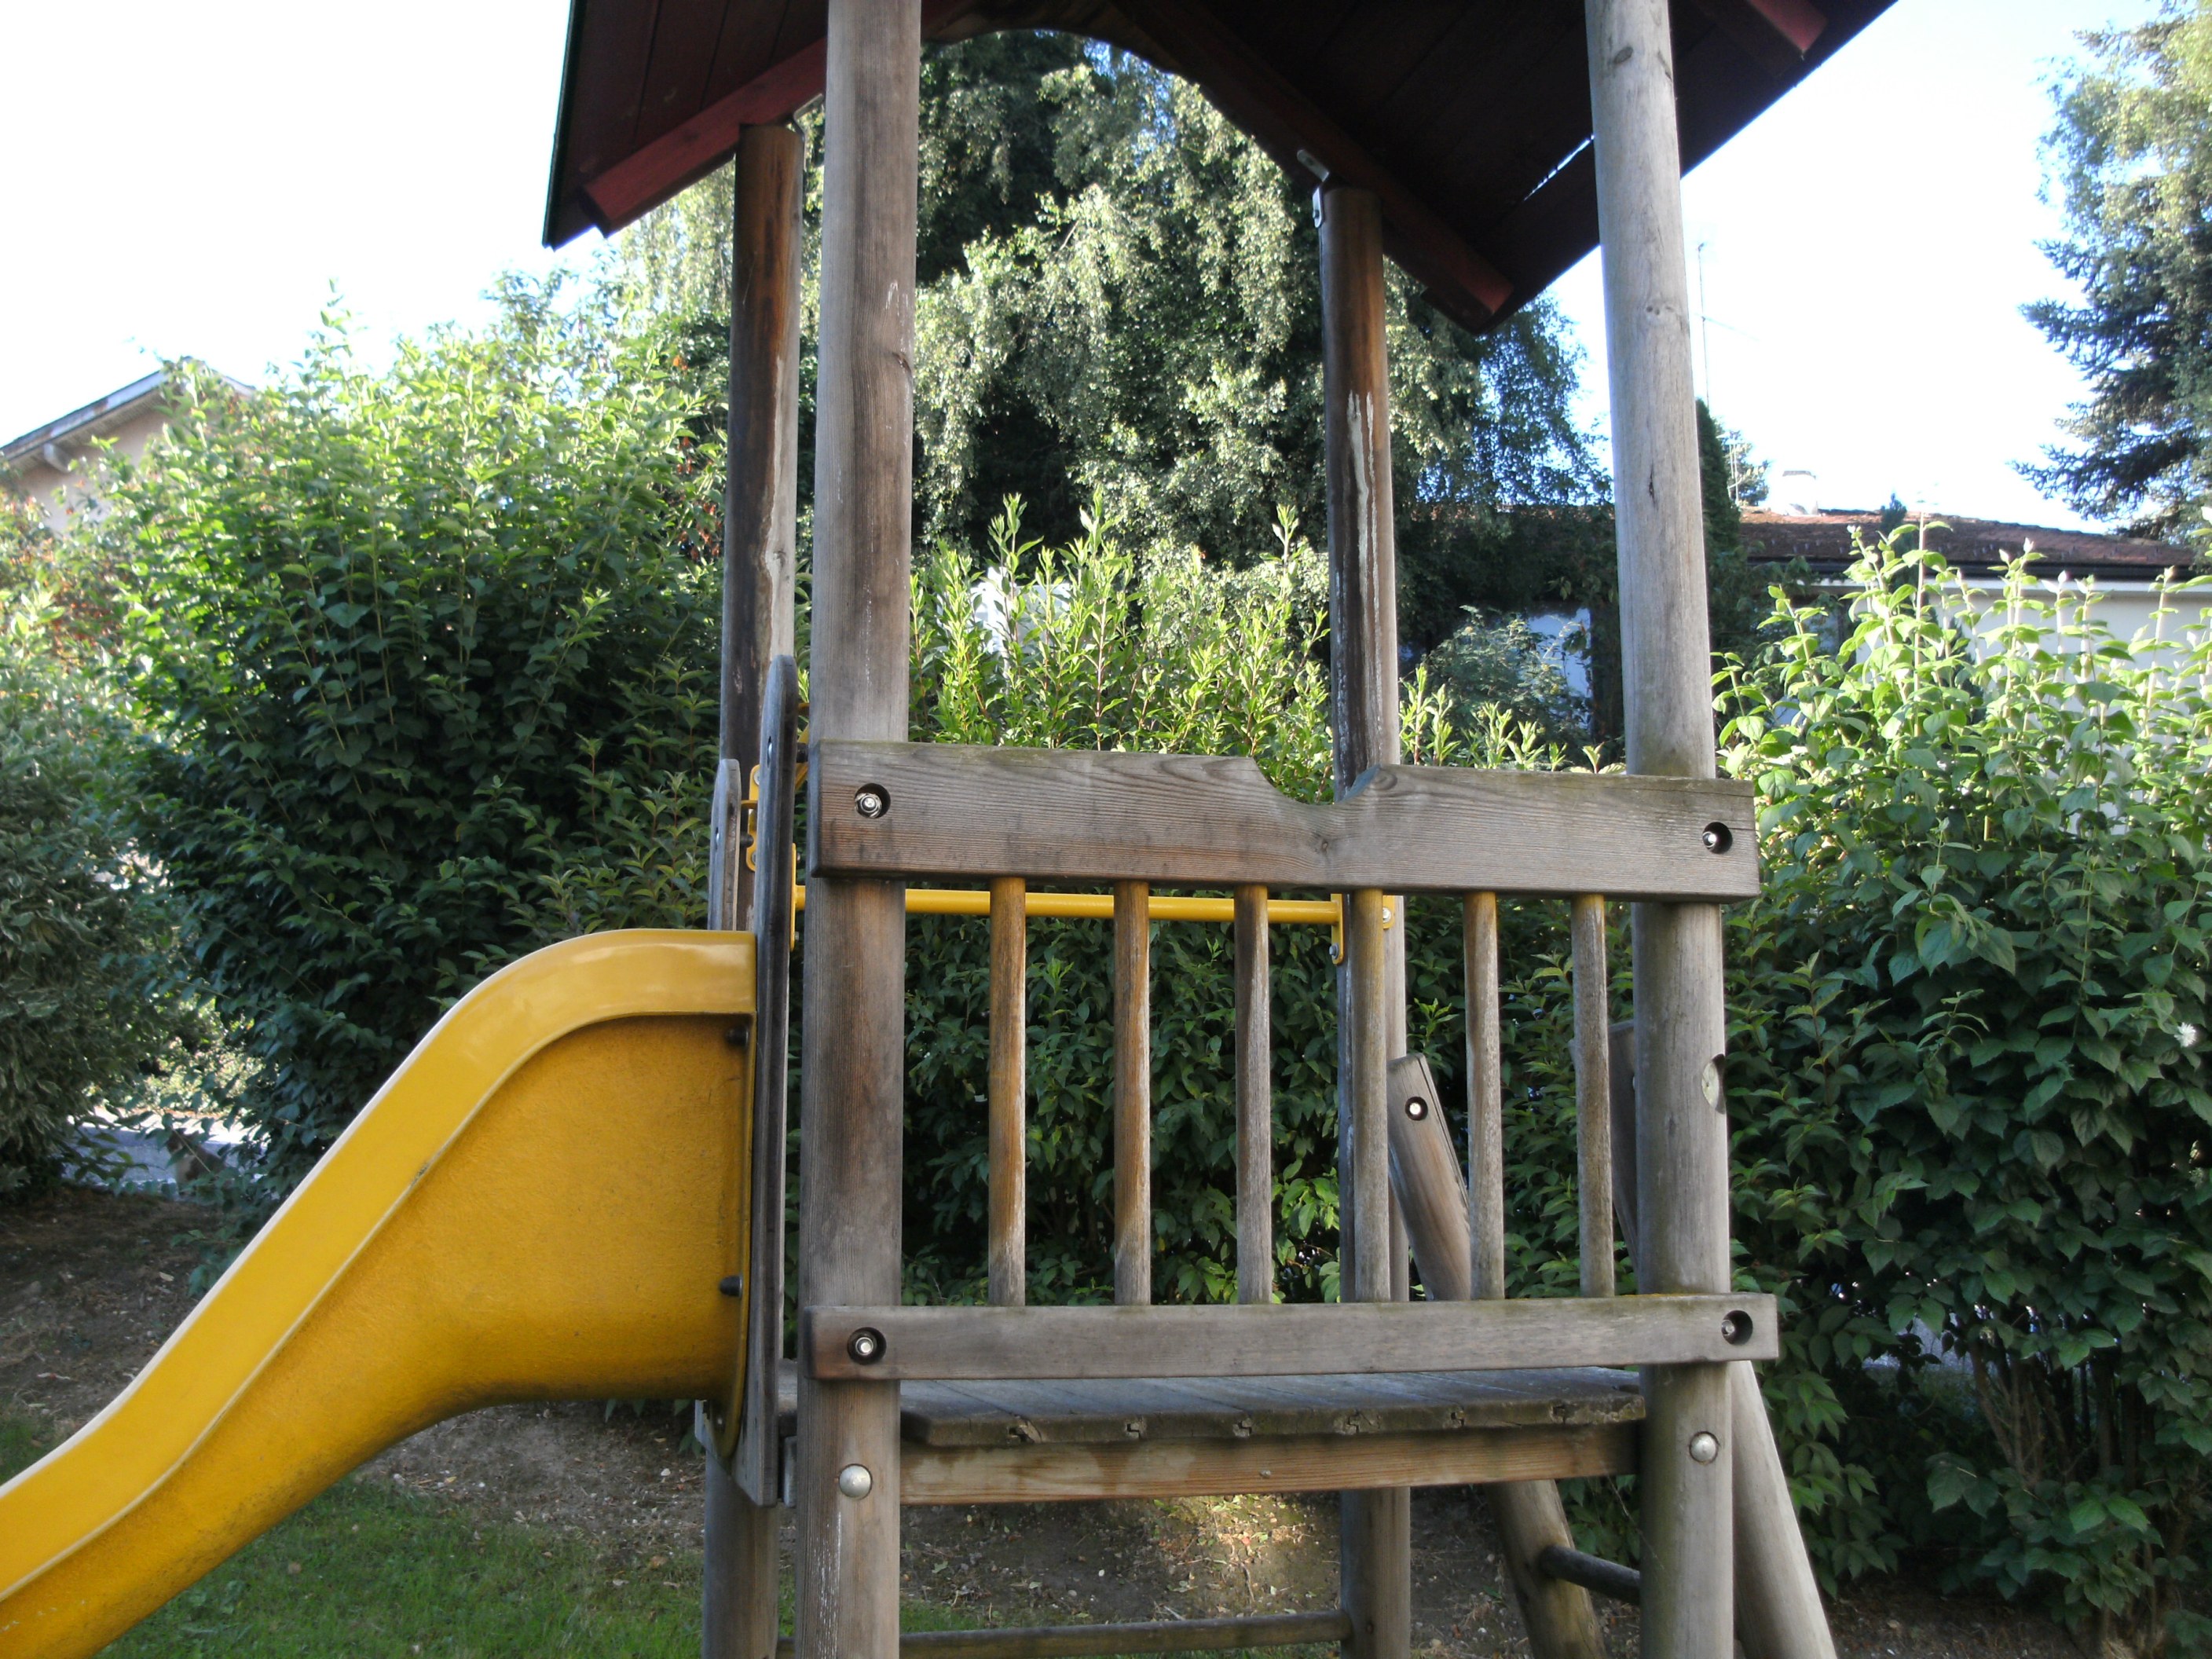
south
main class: Grassland
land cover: Grassland with sparse tree/shrub cover
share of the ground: > 75 %
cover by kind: herbaceous plants 95 %, broadleaved forest trees 5 %
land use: Amenities, museums, leisure
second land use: Residential
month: July
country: AT
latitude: 48.2045
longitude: 13.4843
